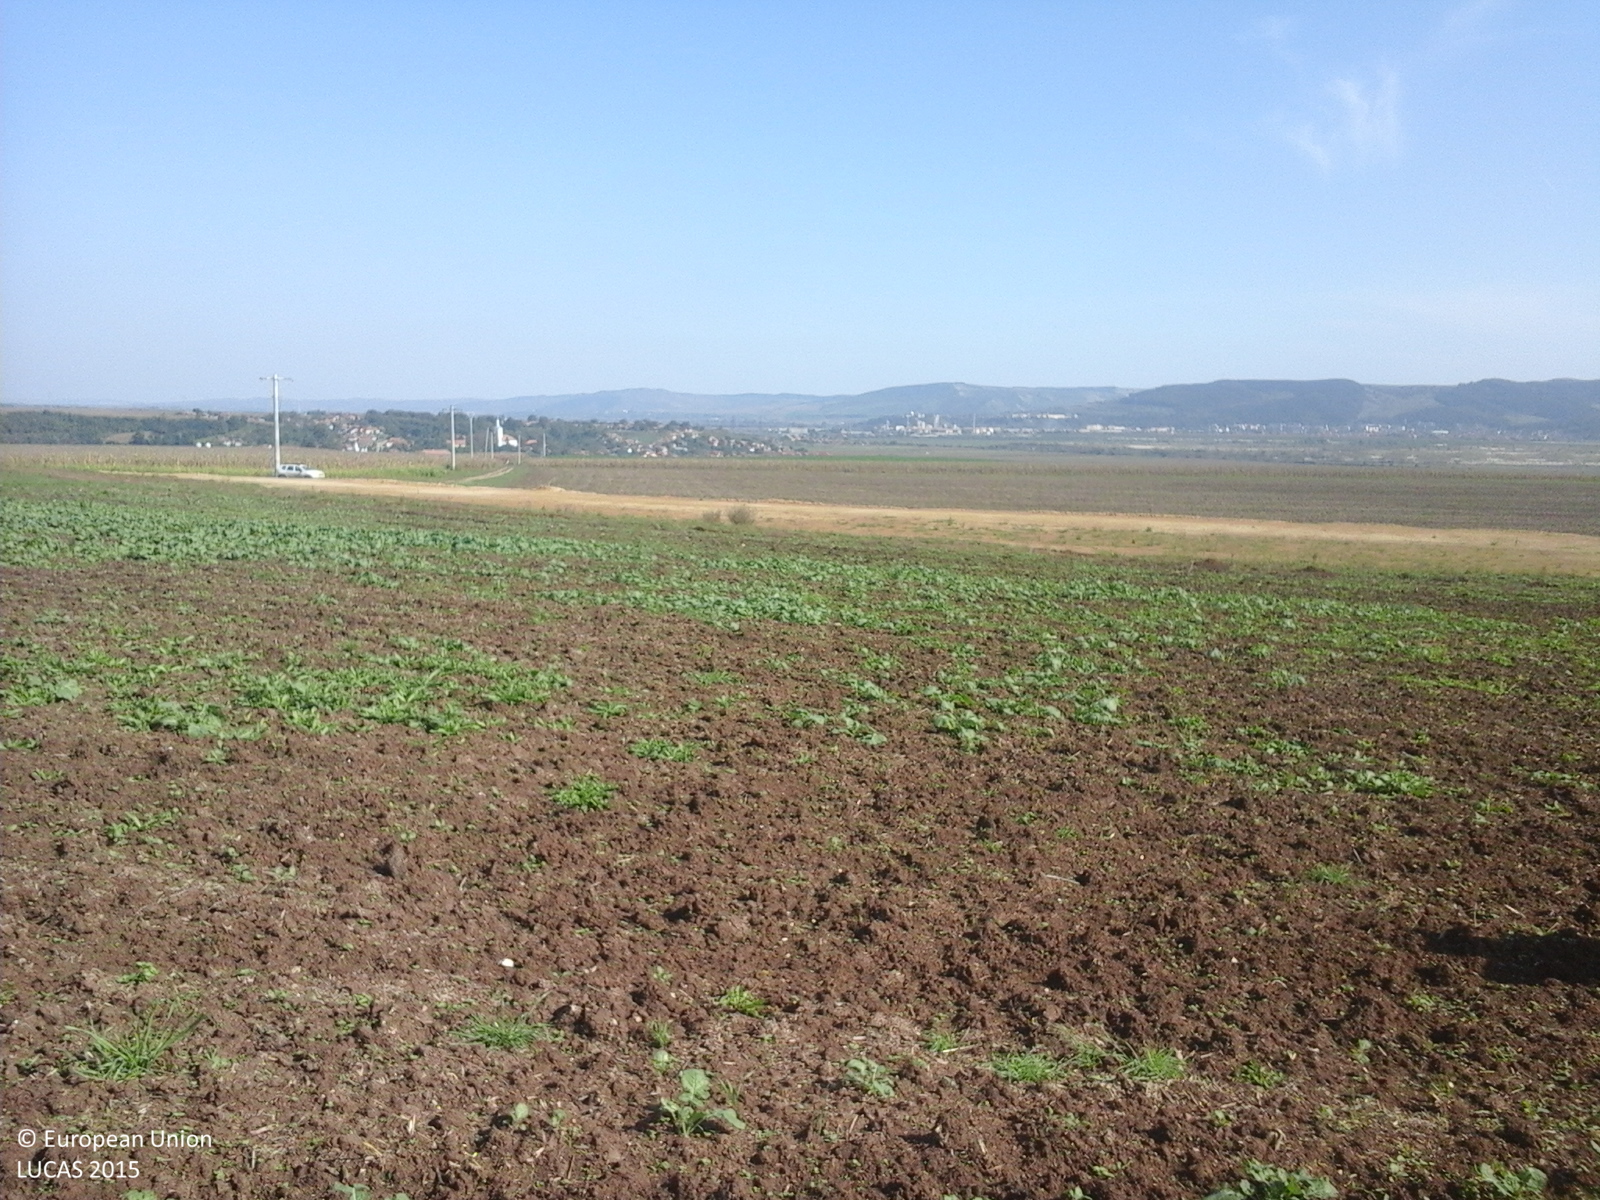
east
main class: Cropland
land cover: Common wheat
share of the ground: < 10 %
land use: Agriculture (excluding fallow land and kitchen gardens)
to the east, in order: Common wheat; Tracks; Common wheat
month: October
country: RO
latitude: 46.4018
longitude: 23.7946
